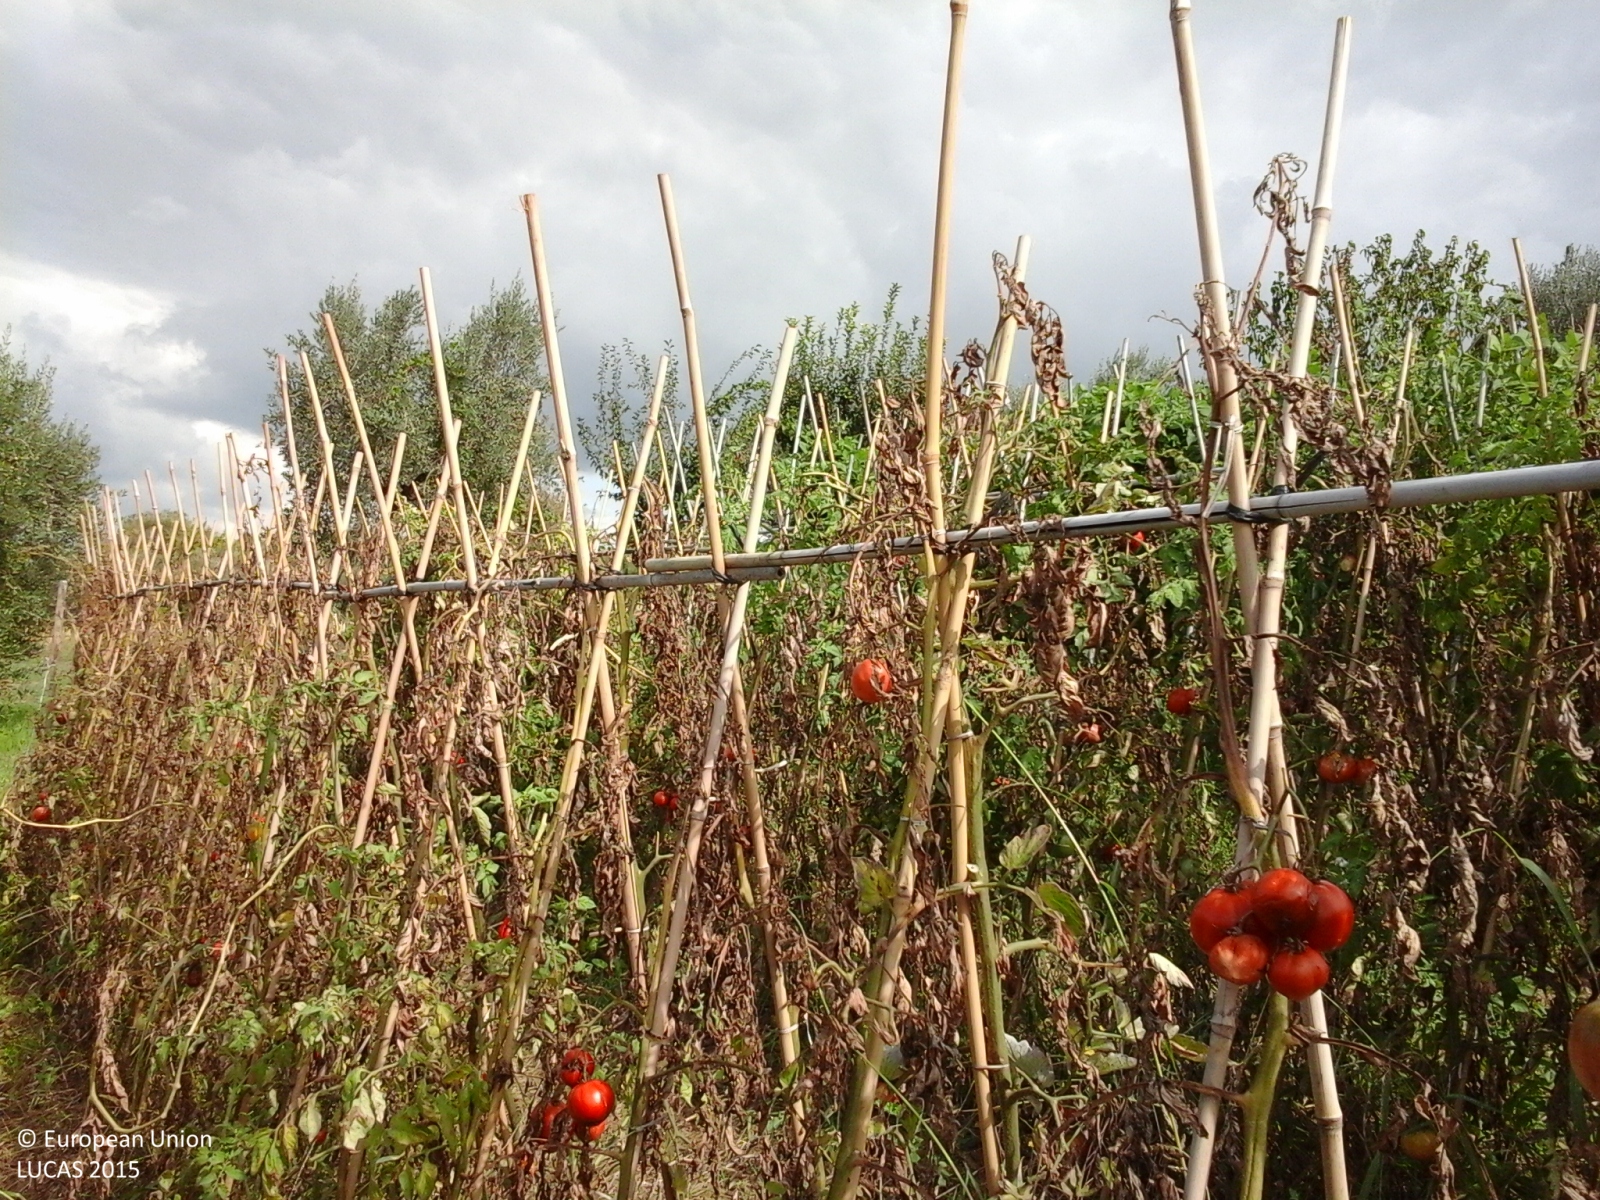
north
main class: Cropland
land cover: Tomatoes
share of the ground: > 75 %
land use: Kitchen garden
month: September
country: IT
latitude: 42.8351
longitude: 13.8186
